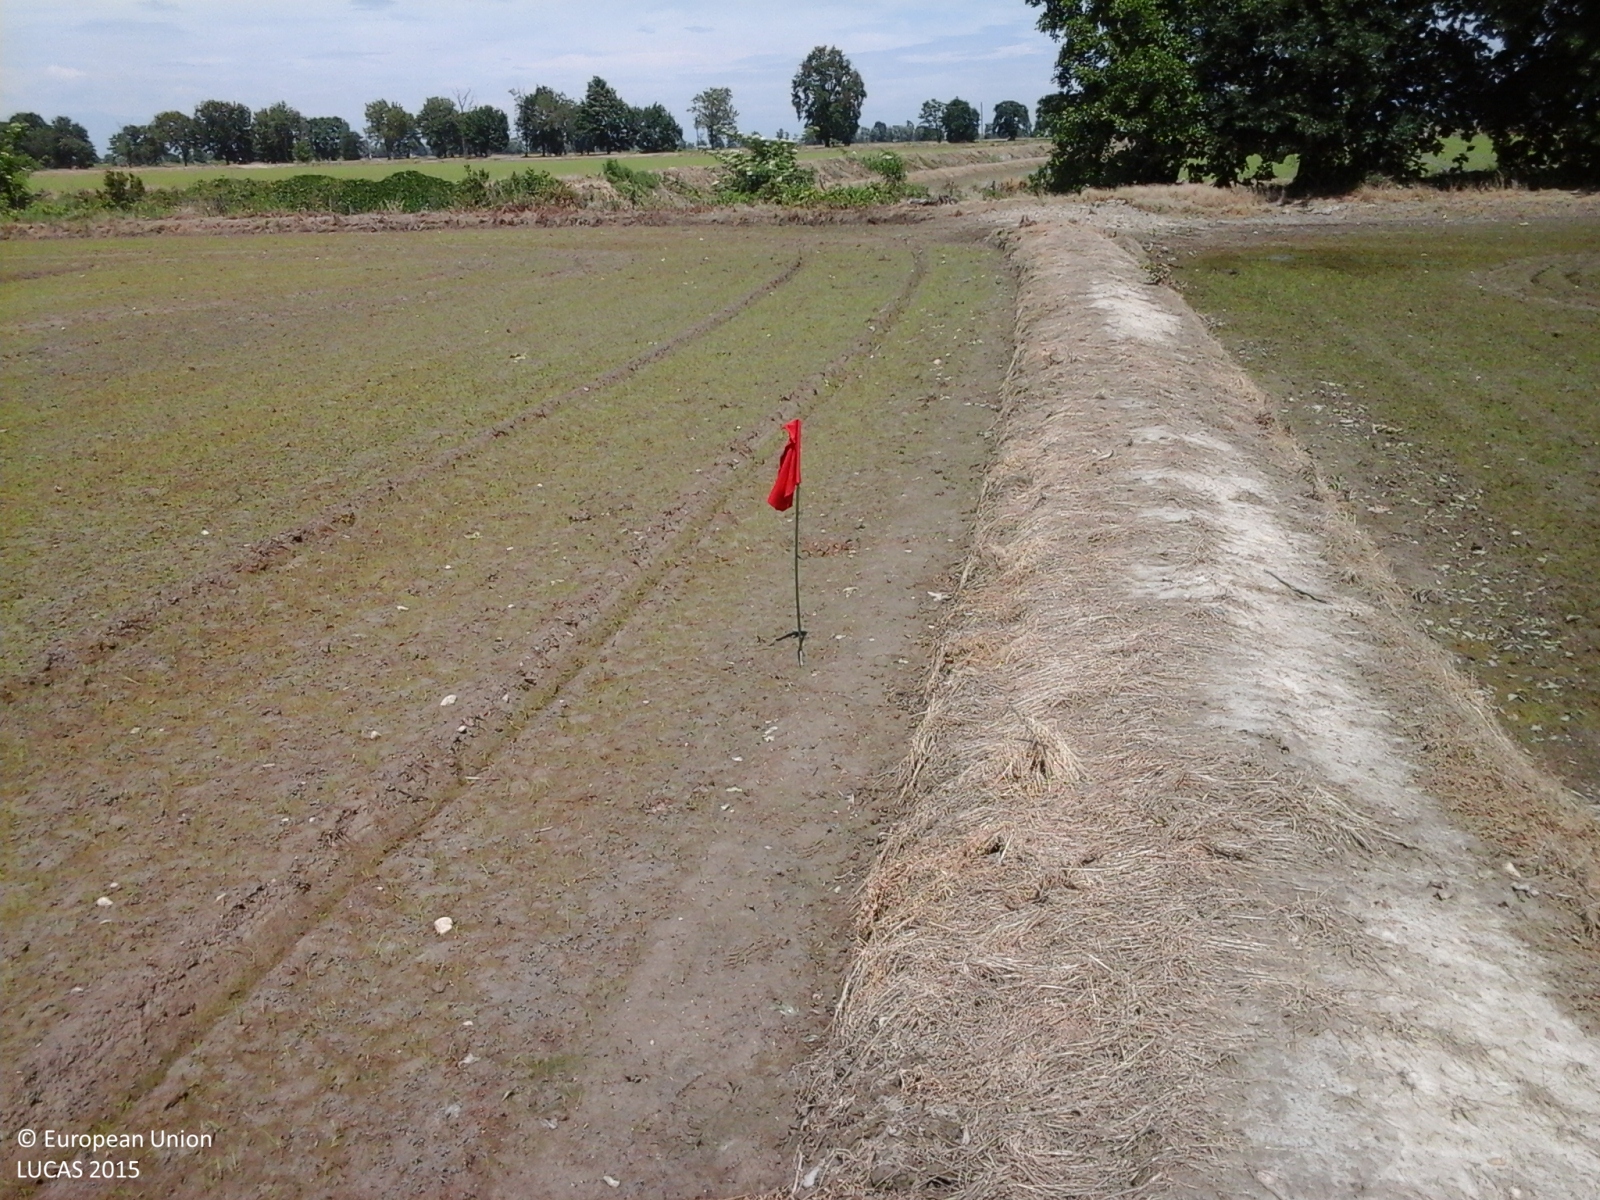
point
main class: Cropland
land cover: Rice
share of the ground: < 10 %
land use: Agriculture (excluding fallow land and kitchen gardens)
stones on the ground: < 10 %
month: May
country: IT
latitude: 45.2548
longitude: 8.2064
